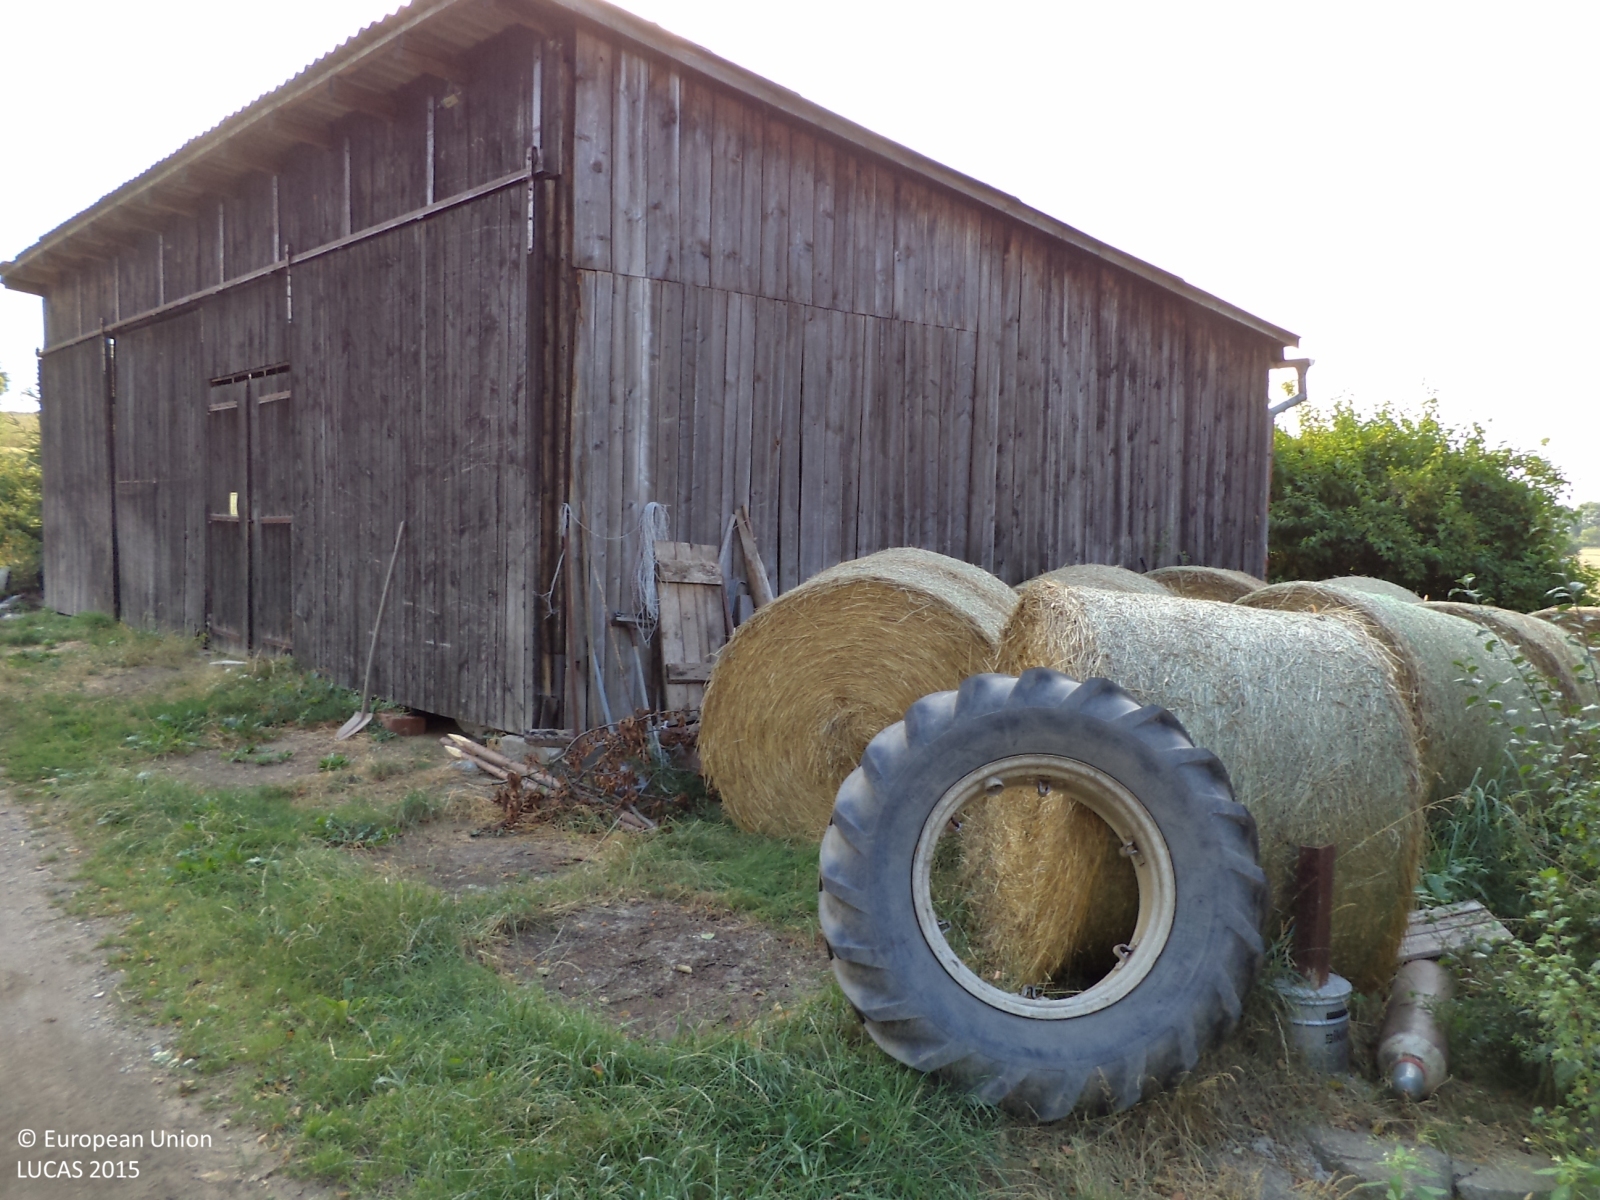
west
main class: Woodland
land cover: Spruce dominated coniferous woodland
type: hemiboreal forest and nemoral coniferous forest and mixed broadleaved-coniferous forest
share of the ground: > 75 %
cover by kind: coniferous forest trees 100 %
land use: Forestry
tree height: > 5 m
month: August
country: CZ
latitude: 49.5564
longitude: 14.4666
